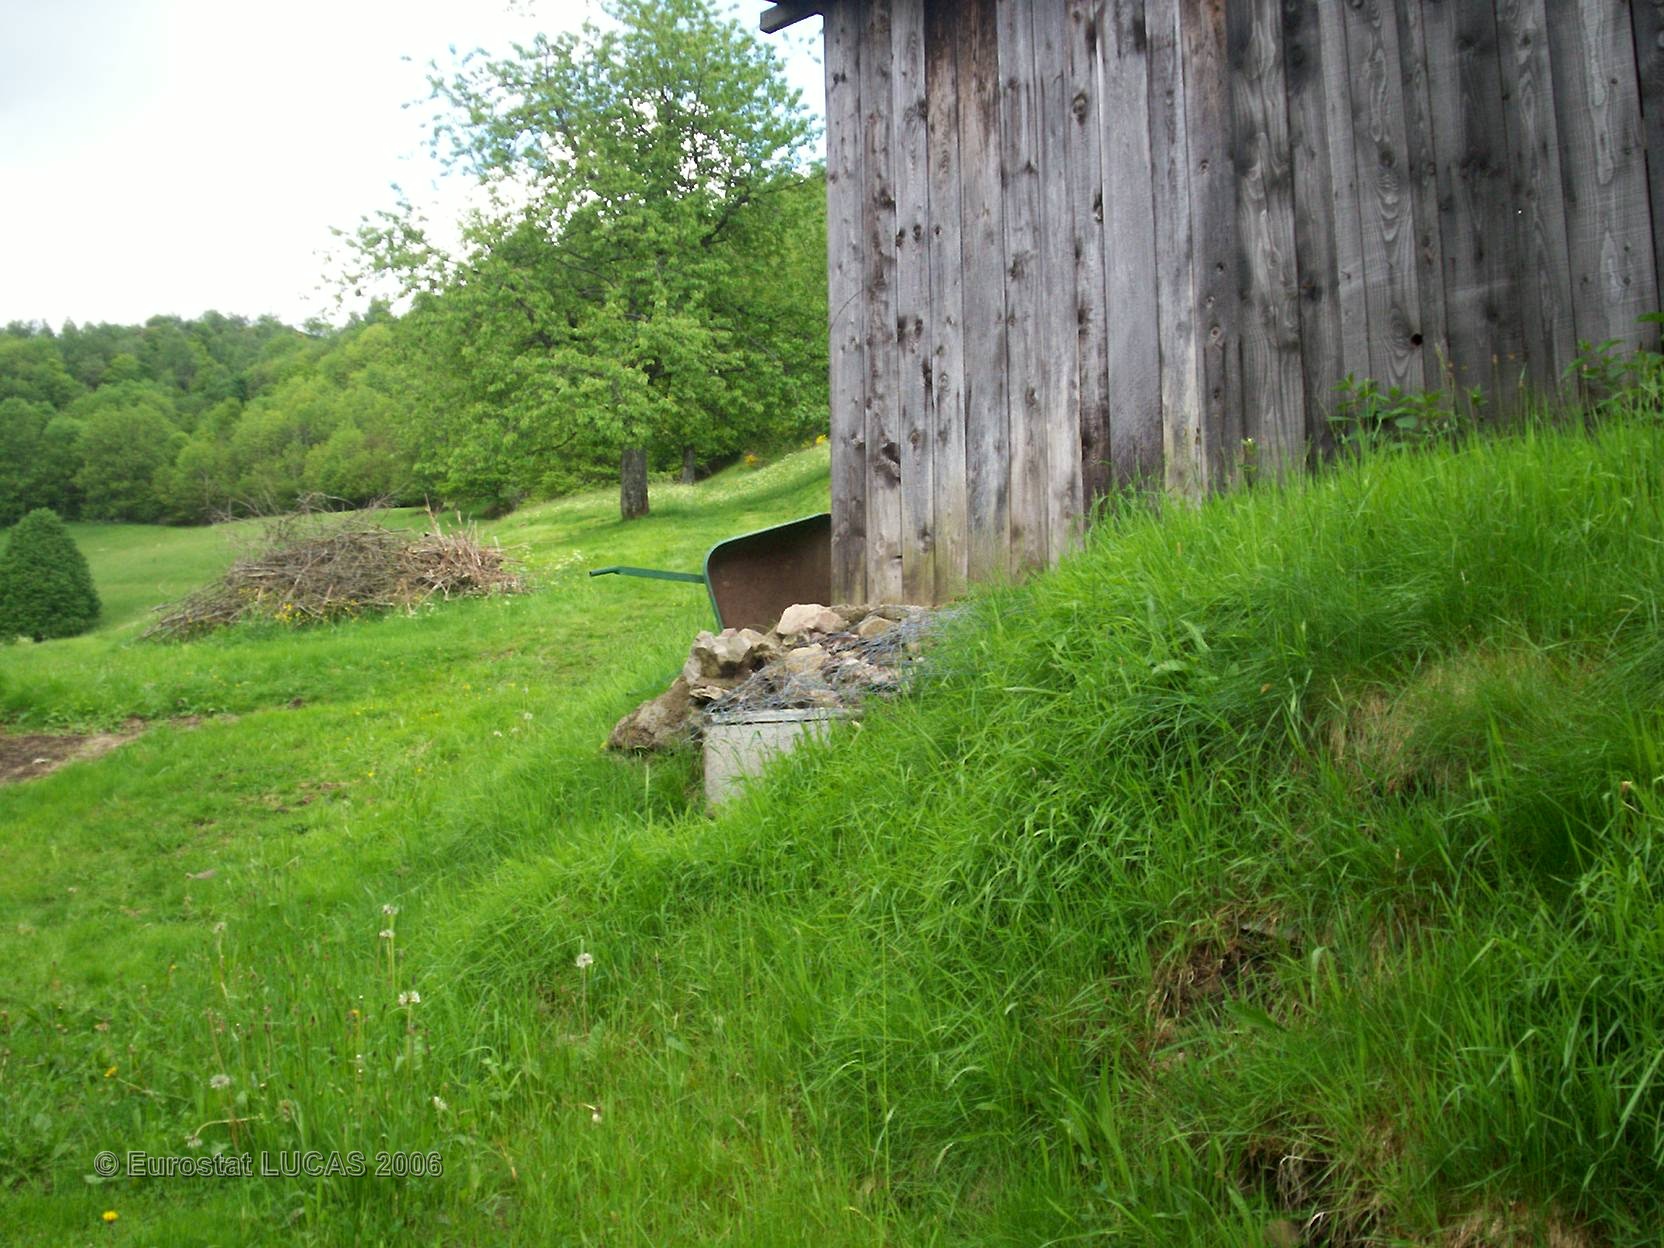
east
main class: Grassland
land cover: Grassland with sparse tree/shrub cover
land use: Agriculture (excluding fallow land and kitchen gardens)
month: June
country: FR
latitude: 47.8883
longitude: 6.7781
